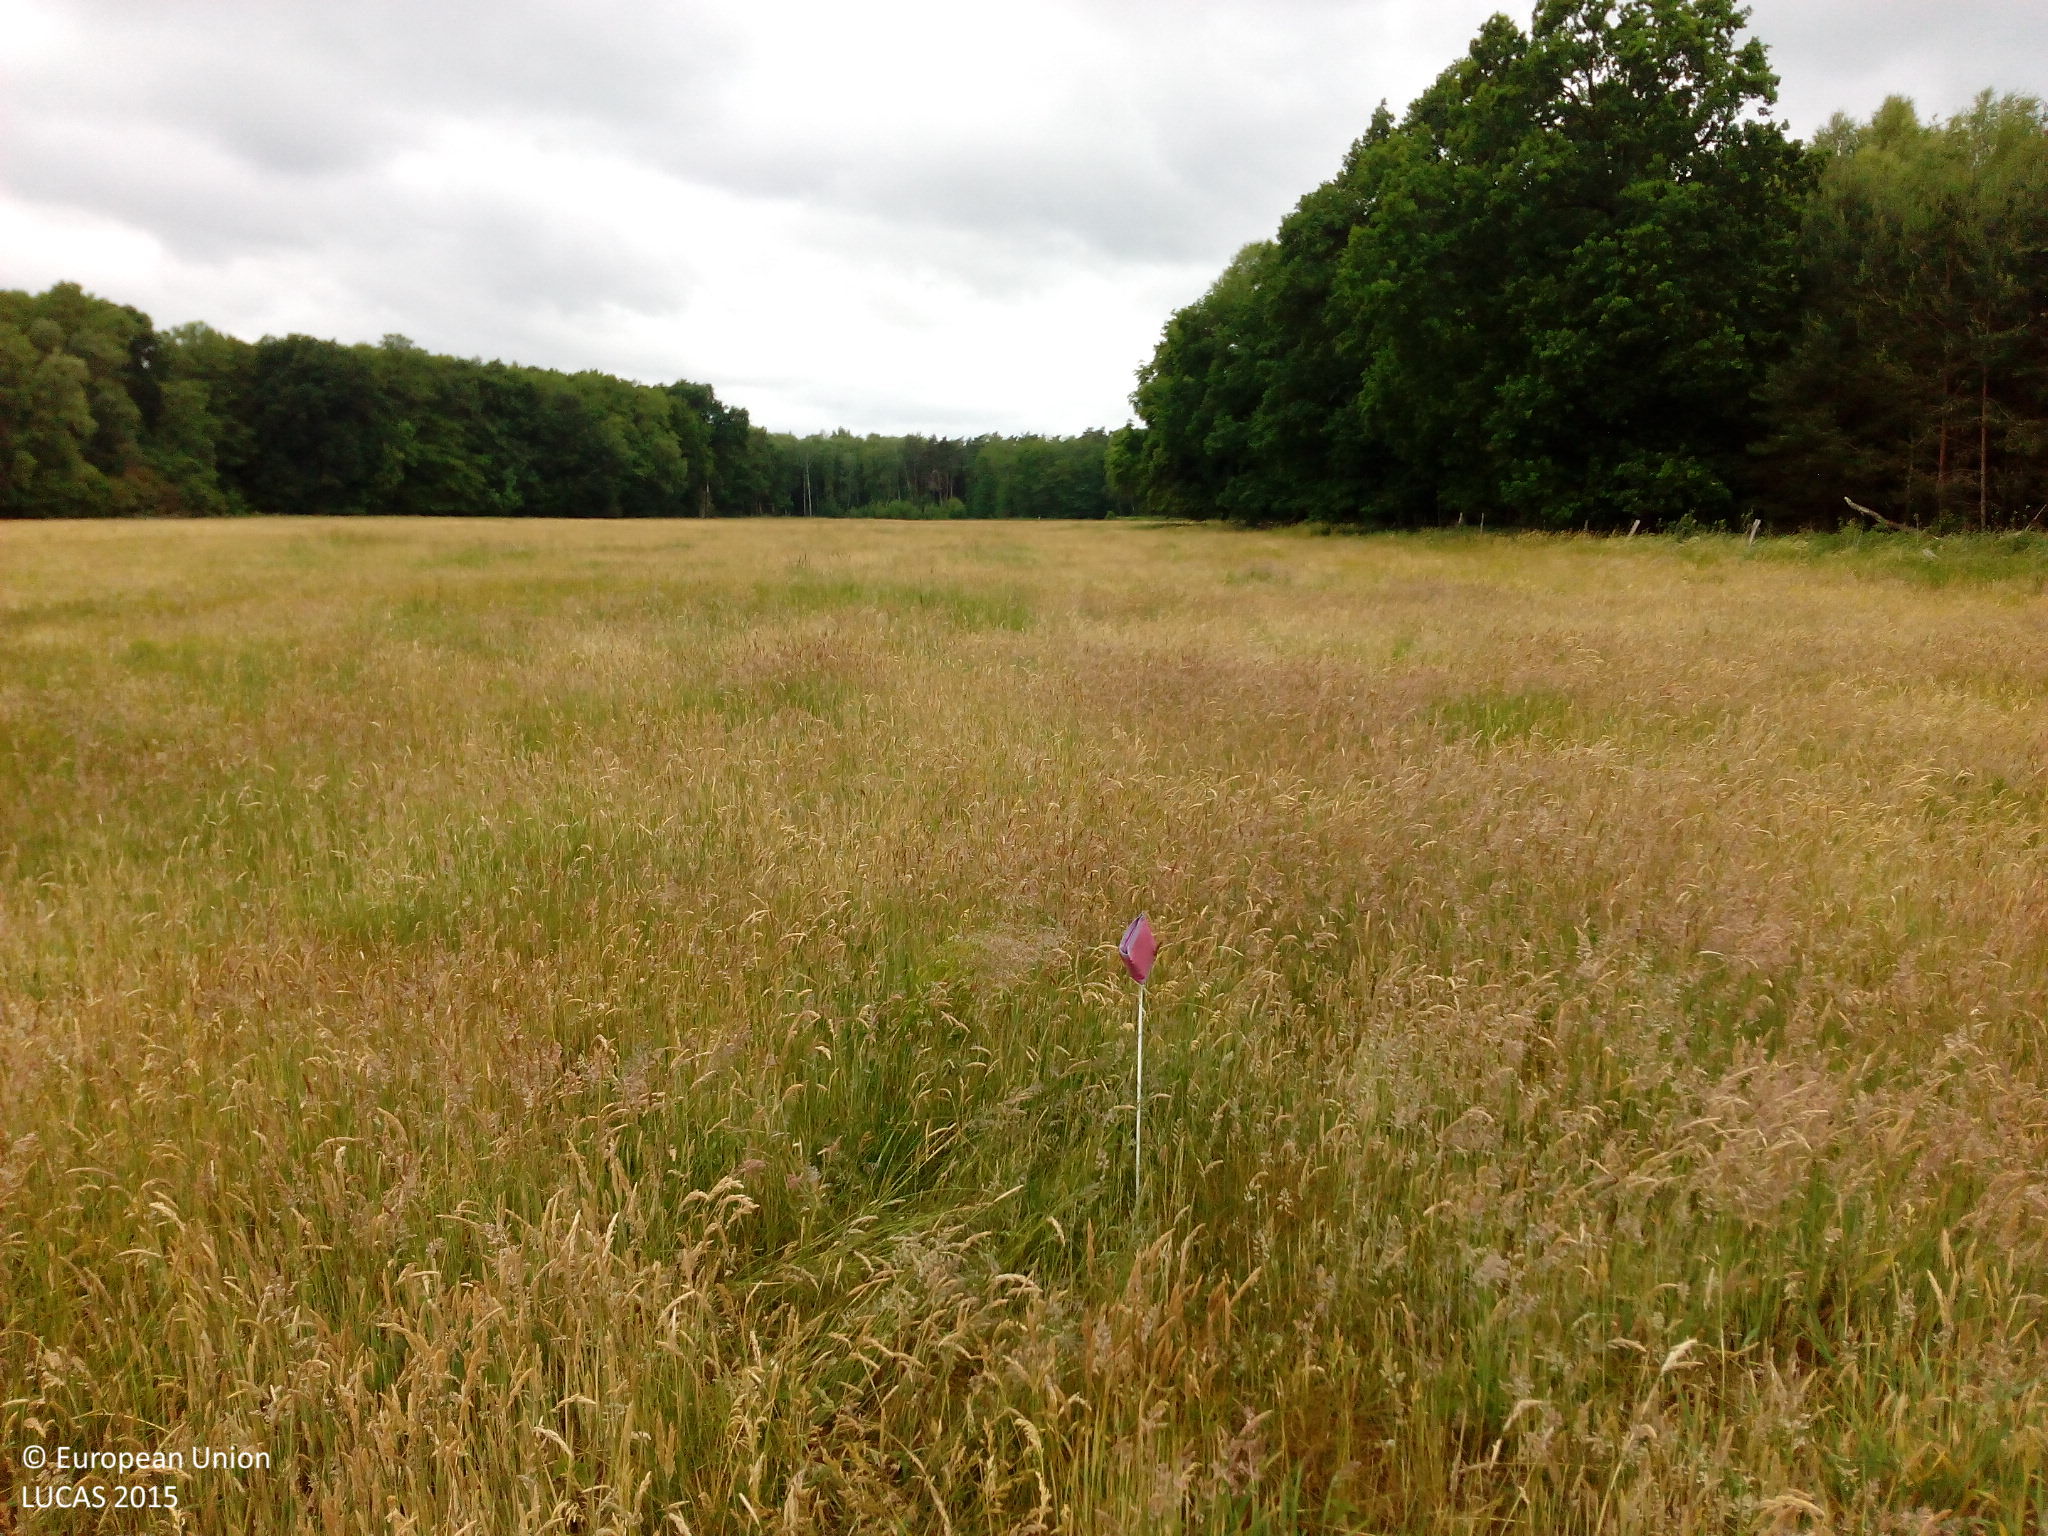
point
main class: Grassland
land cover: Spontaneously vegetated surfaces
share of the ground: > 75 %
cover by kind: herbaceous plants 100 %
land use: Semi-natural and natural areas not in use
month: June
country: DE
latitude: 52.6043
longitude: 12.4359
